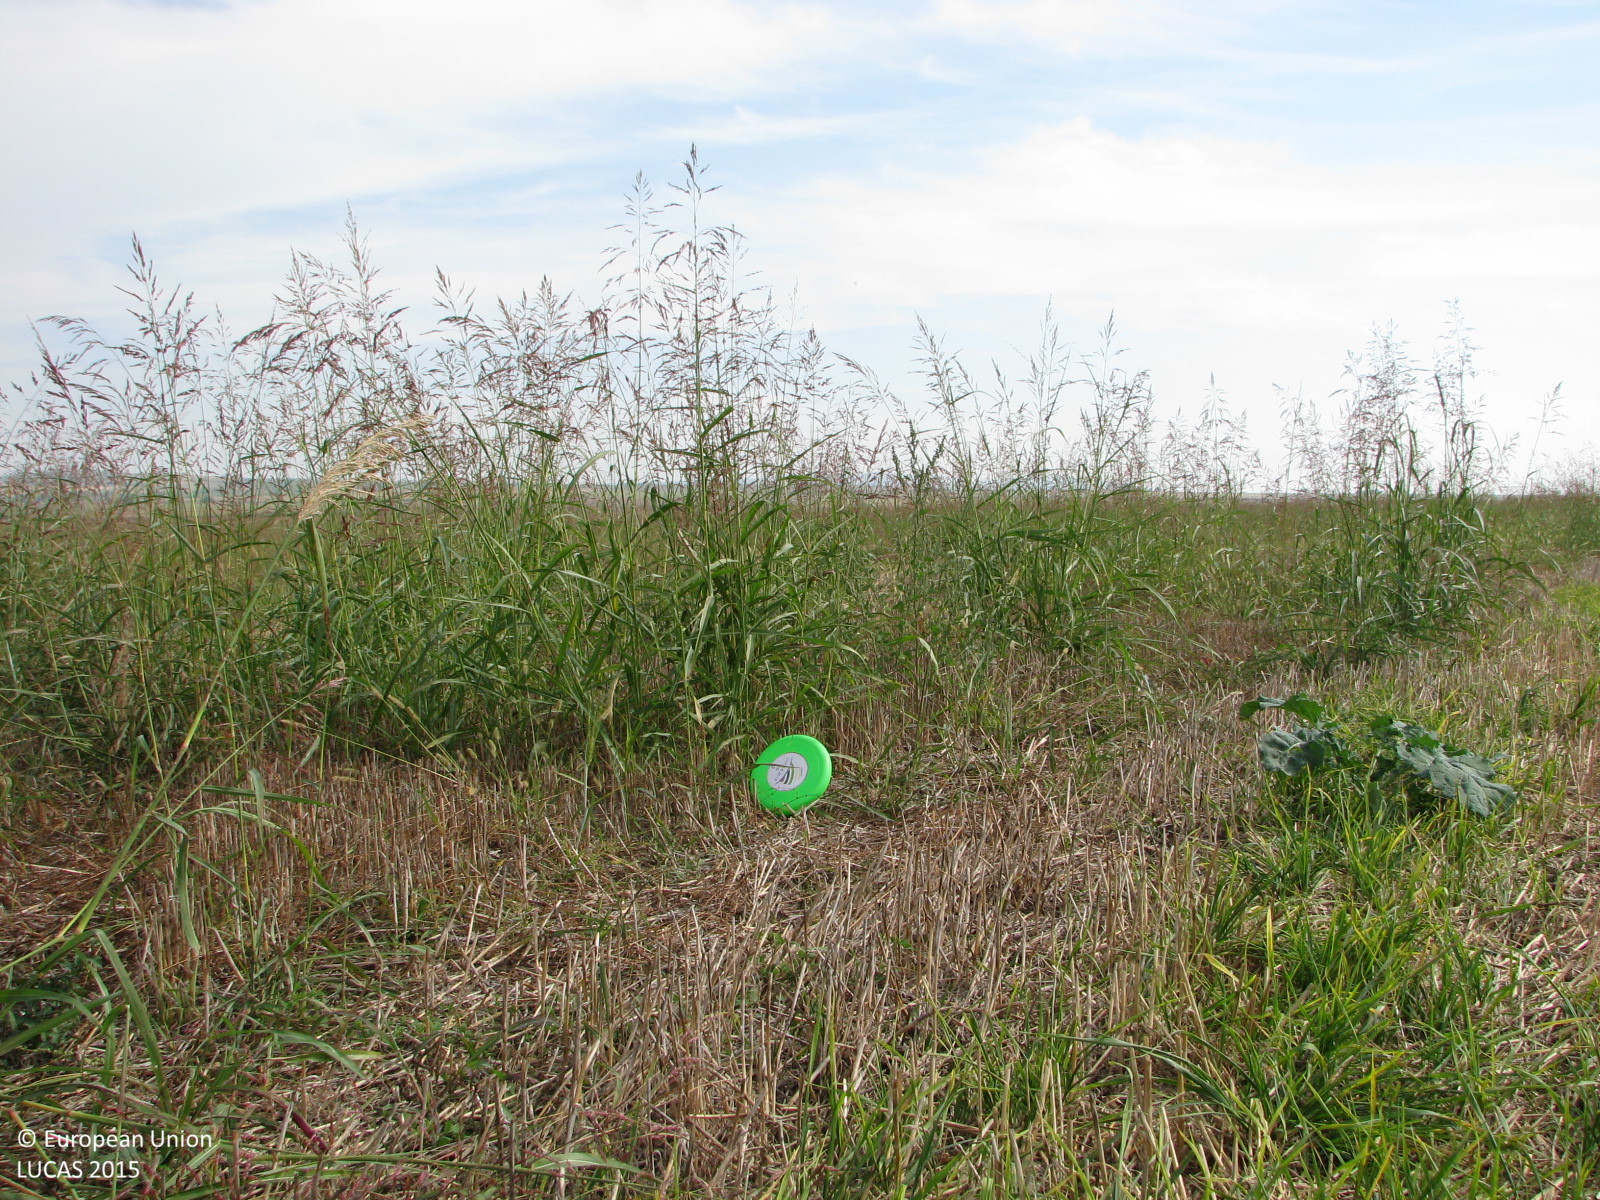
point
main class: Cropland
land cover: Oats
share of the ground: 50 - 75 %
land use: Agriculture (excluding fallow land and kitchen gardens)
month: October
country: BG
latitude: 42.4178
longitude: 26.0121
